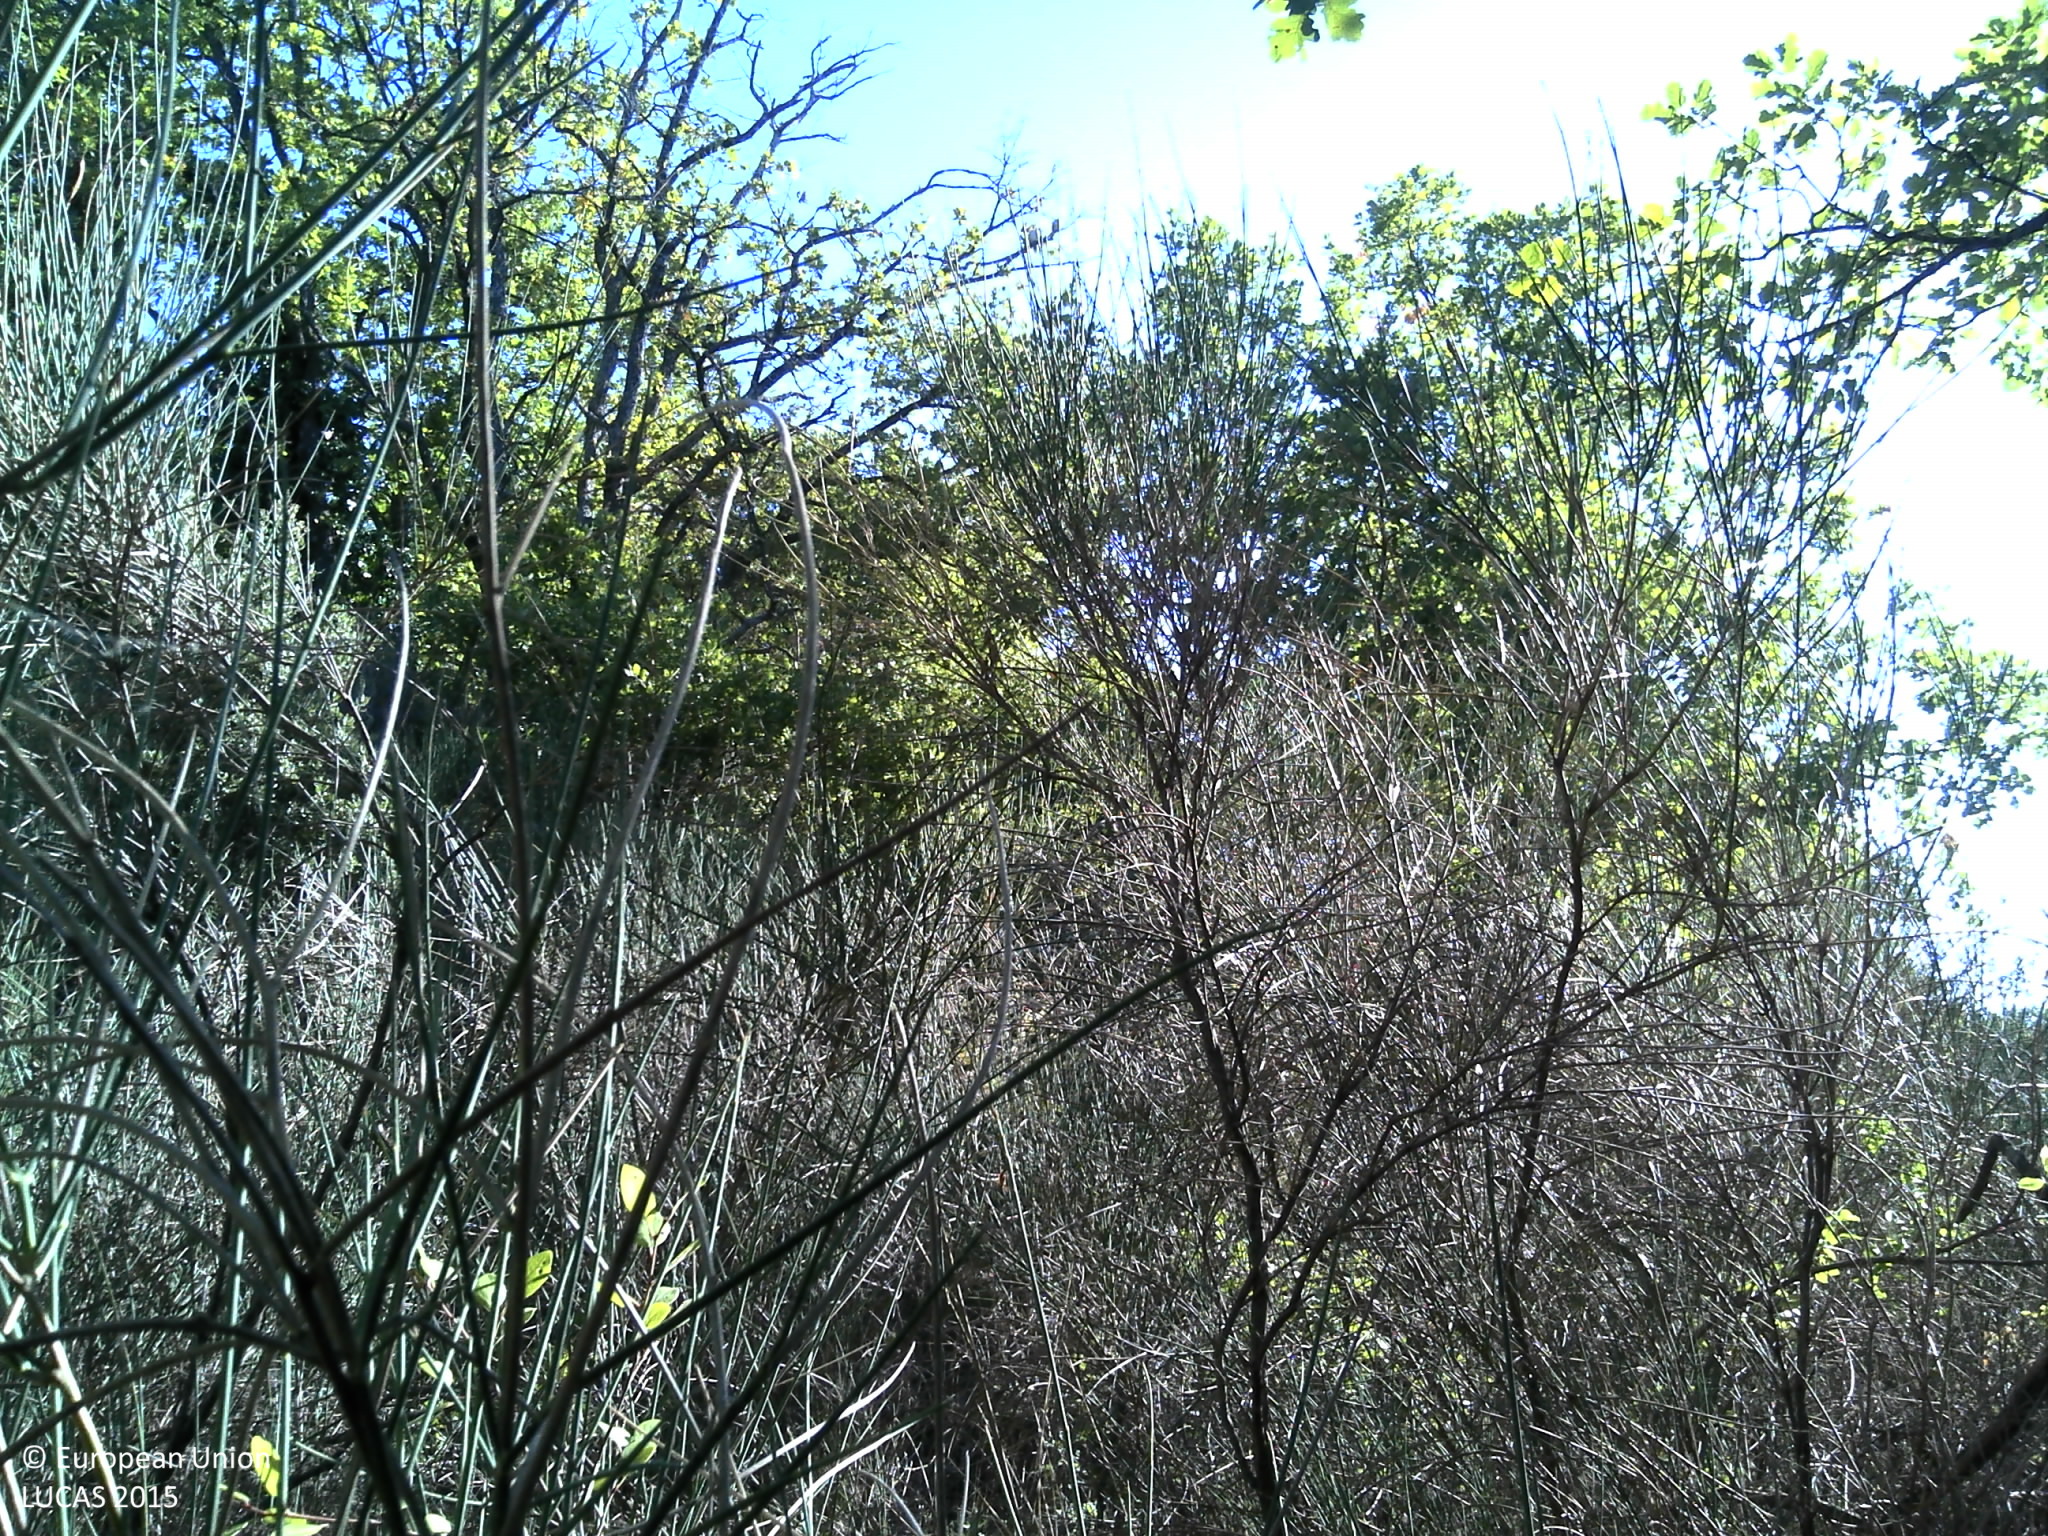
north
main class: Woodland
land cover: Broadleaved woodland
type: thermophilous deciduous forest
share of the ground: 50 - 75 %
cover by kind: broadleaved forest trees 70 %, shrubs 20 %, coniferous forest trees 10 %
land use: Forestry
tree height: > 5 m
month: September
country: FR
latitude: 43.7864
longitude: 5.5726
